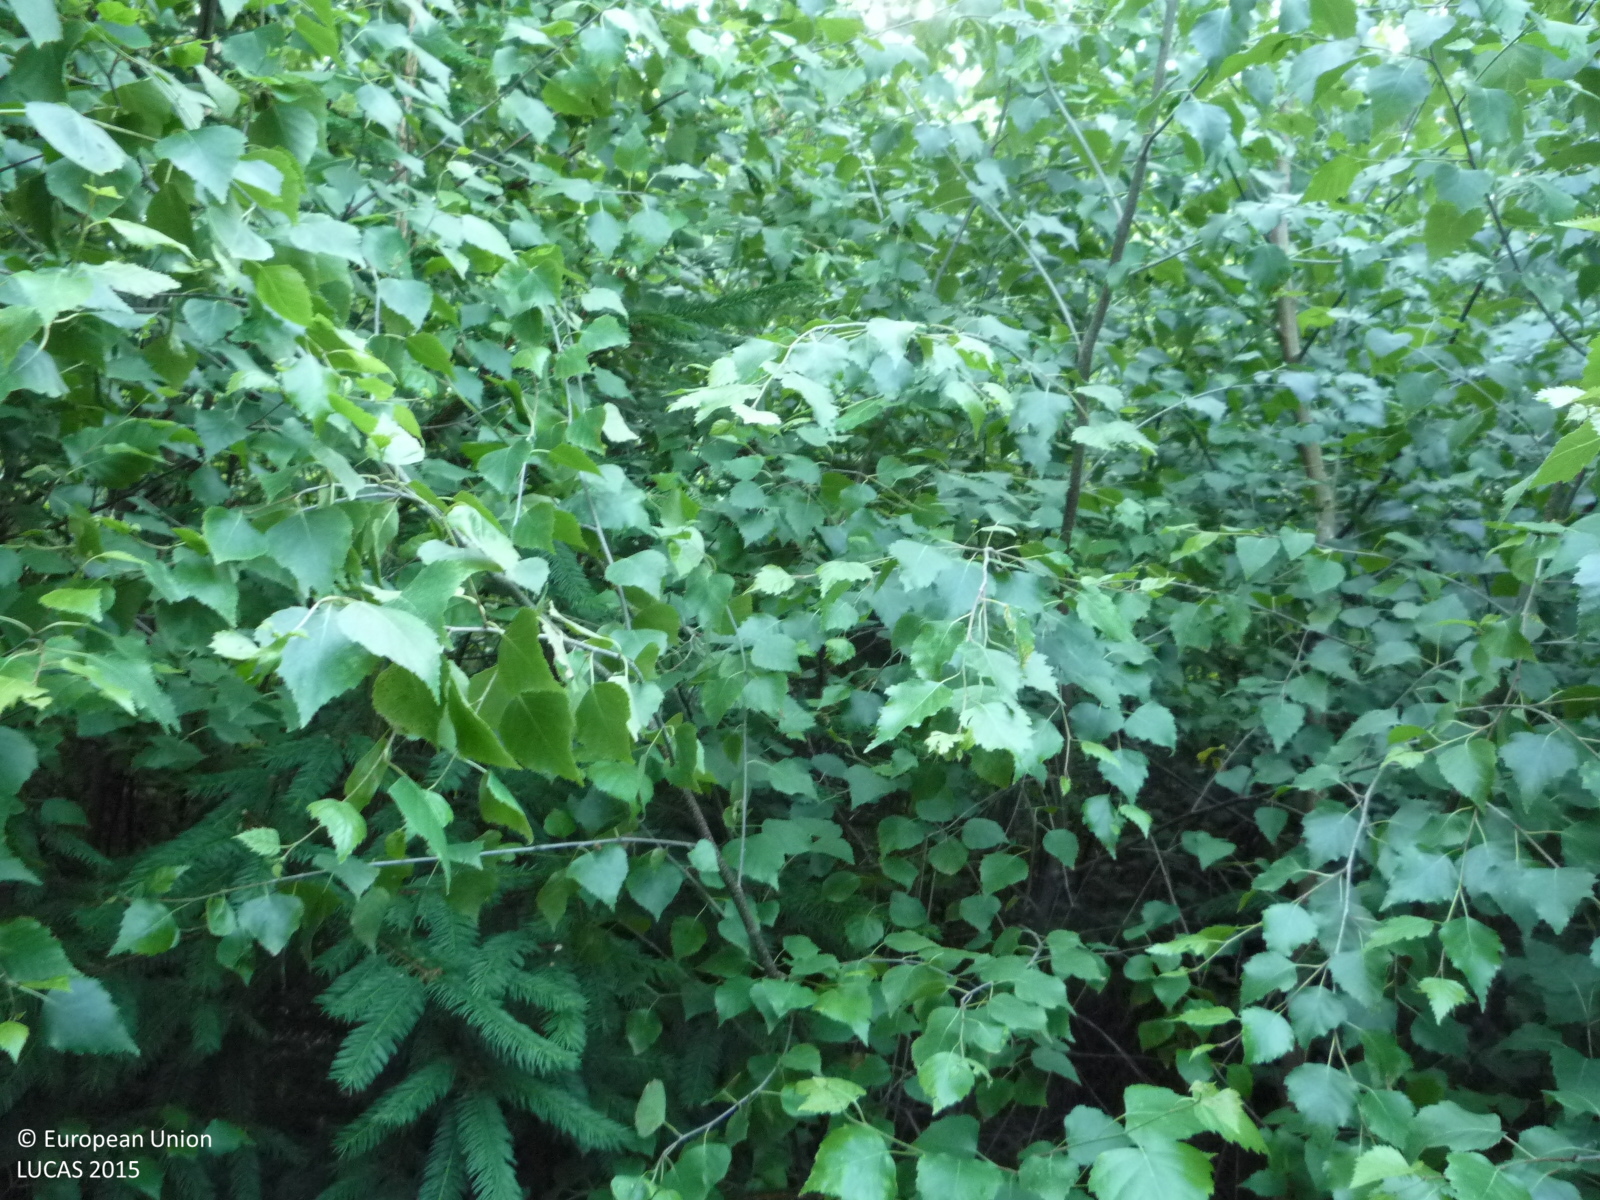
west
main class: Woodland
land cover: Spruce dominated mixed woodland
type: hemiboreal forest and nemoral coniferous forest and mixed broadleaved-coniferous forest
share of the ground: > 75 %
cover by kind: broadleaved forest trees 55 %, coniferous forest trees 30 %, shrubs 15 %
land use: Forestry
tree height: > 5 m
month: June
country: CZ
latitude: 49.7806
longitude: 15.1275
